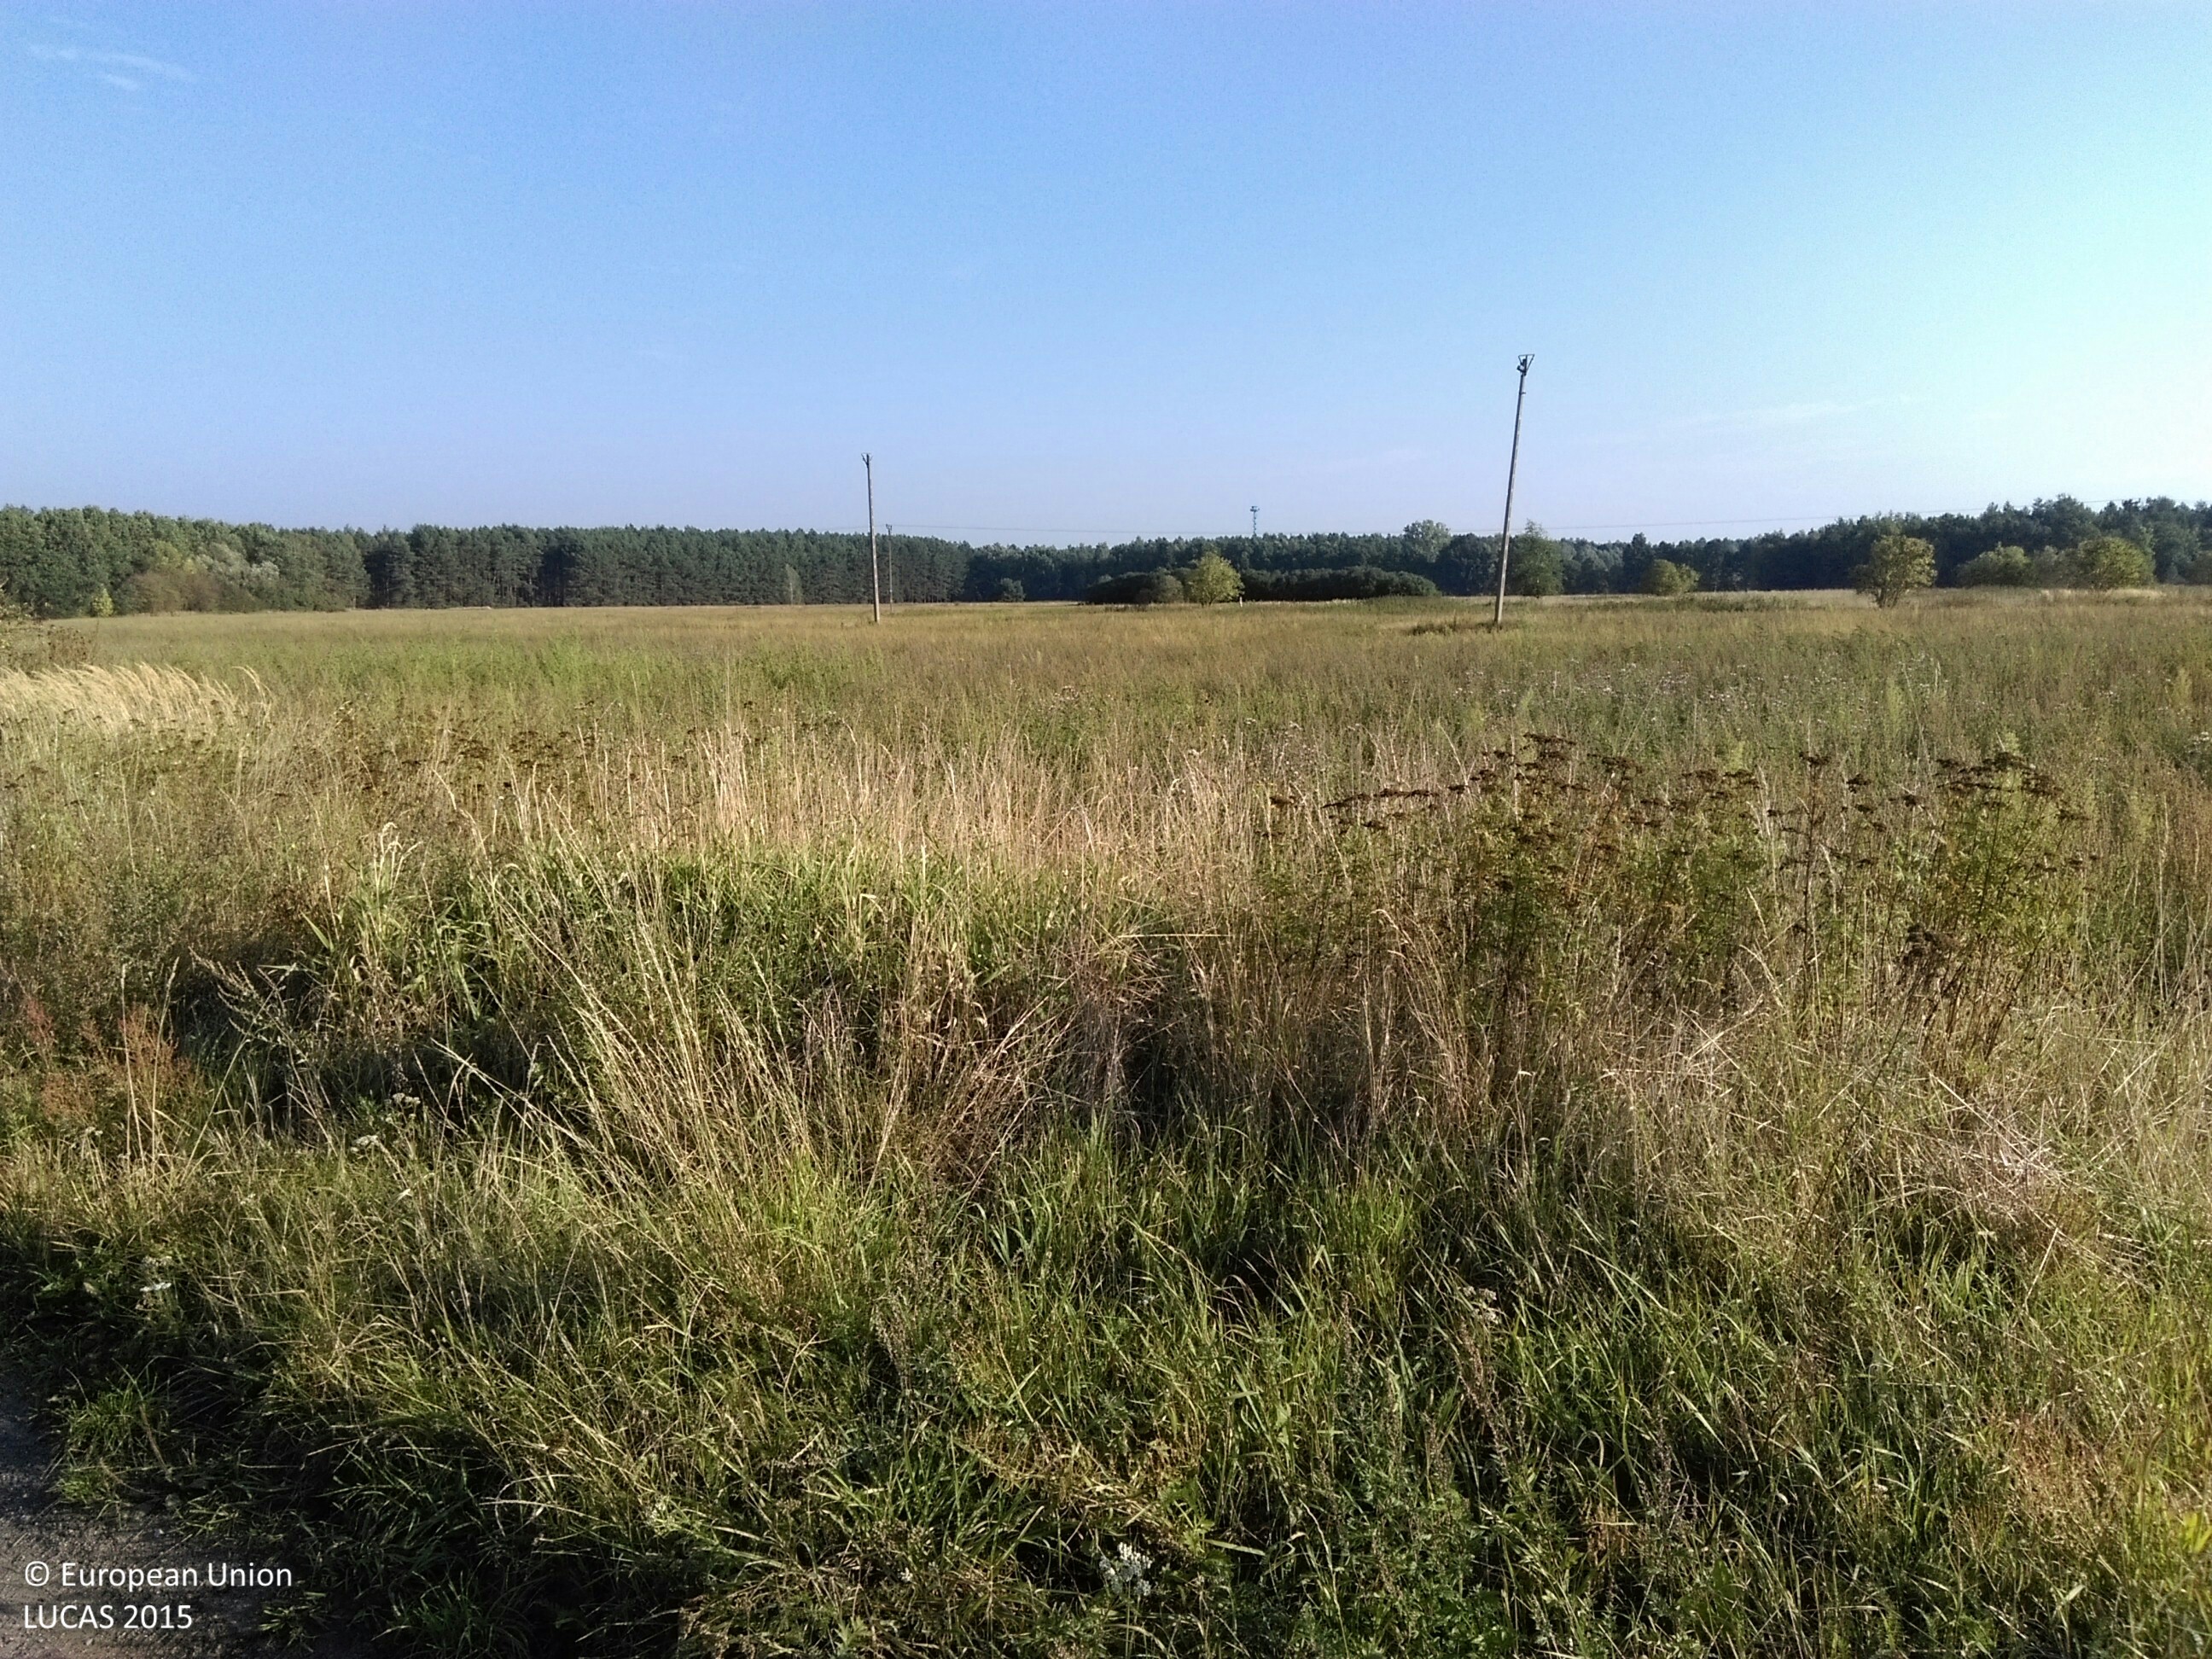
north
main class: Cropland
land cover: Triticale
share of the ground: < 10 %
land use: Agriculture (excluding fallow land and kitchen gardens)
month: September
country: PL
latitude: 51.7969
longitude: 15.5579
